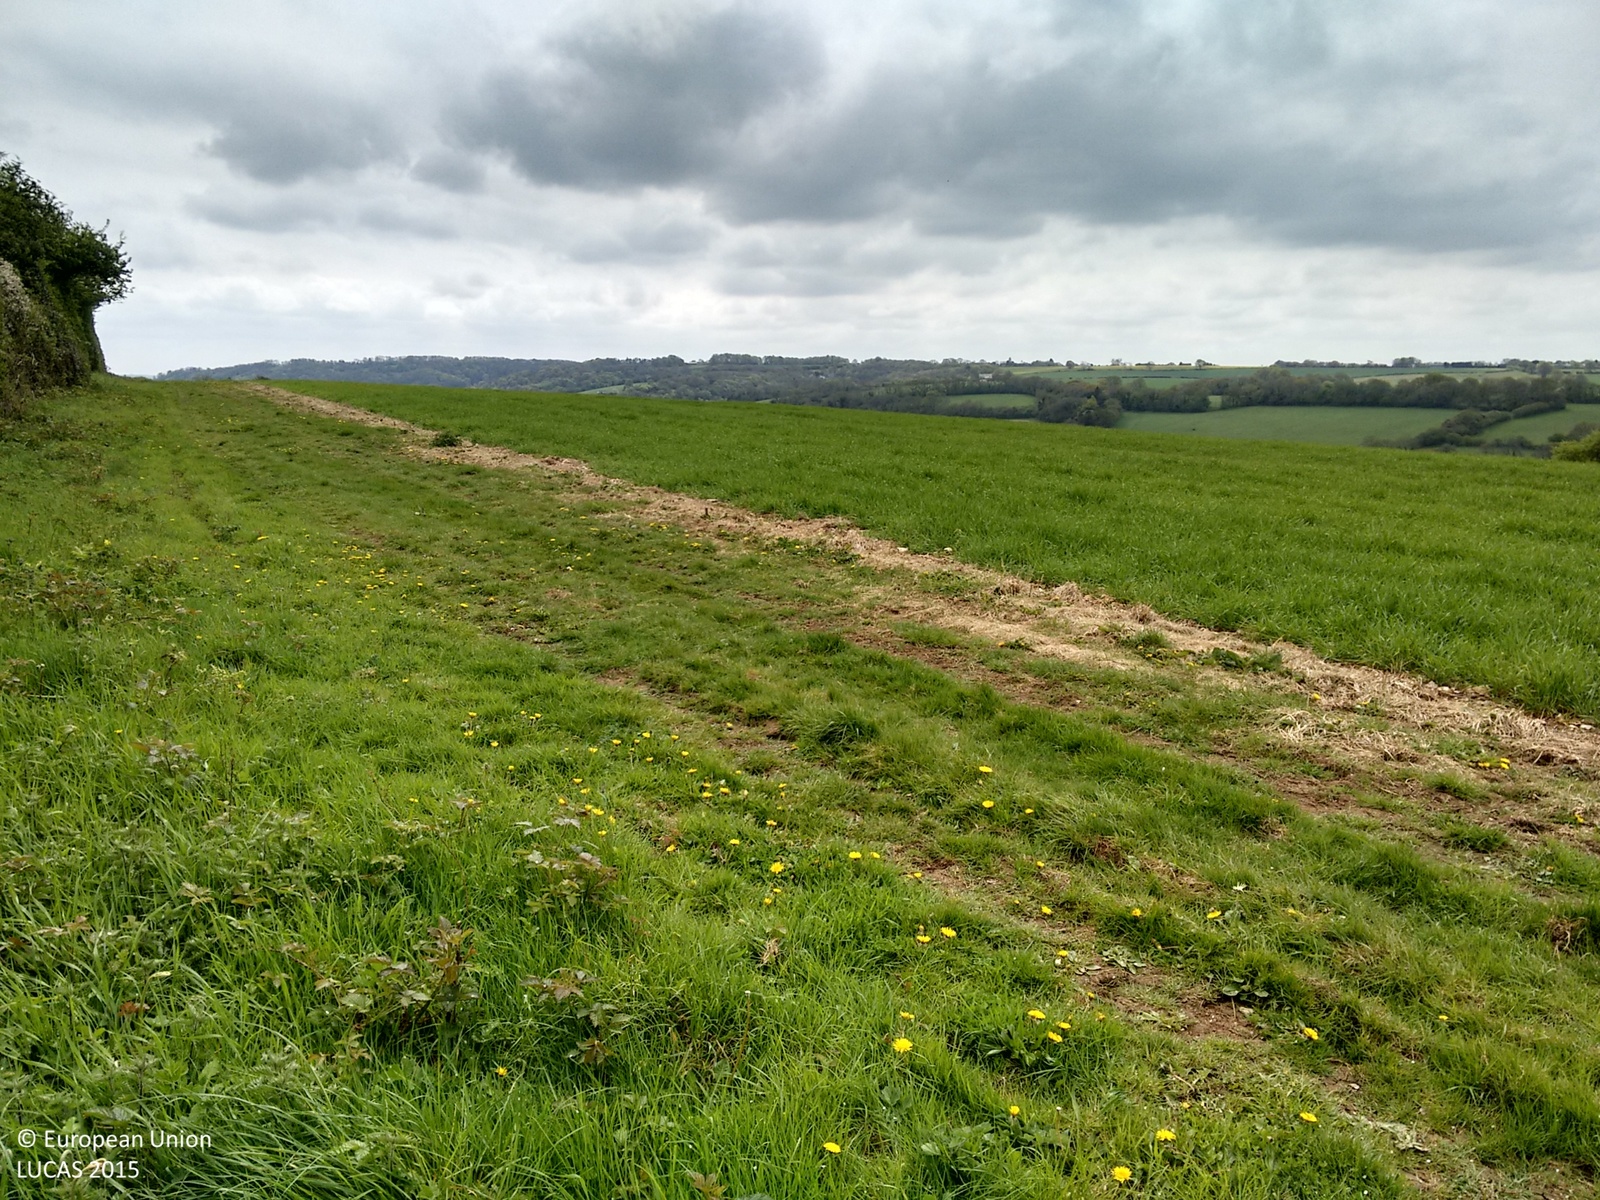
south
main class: Shrubland
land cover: Shrubland with sparse tree cover
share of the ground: > 75 %
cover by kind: shrubs 95 %, broadleaved forest trees 5 %
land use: Agriculture (excluding fallow land and kitchen gardens)
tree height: < 5 m
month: May
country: GB
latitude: 51.0697
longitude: -0.9613
